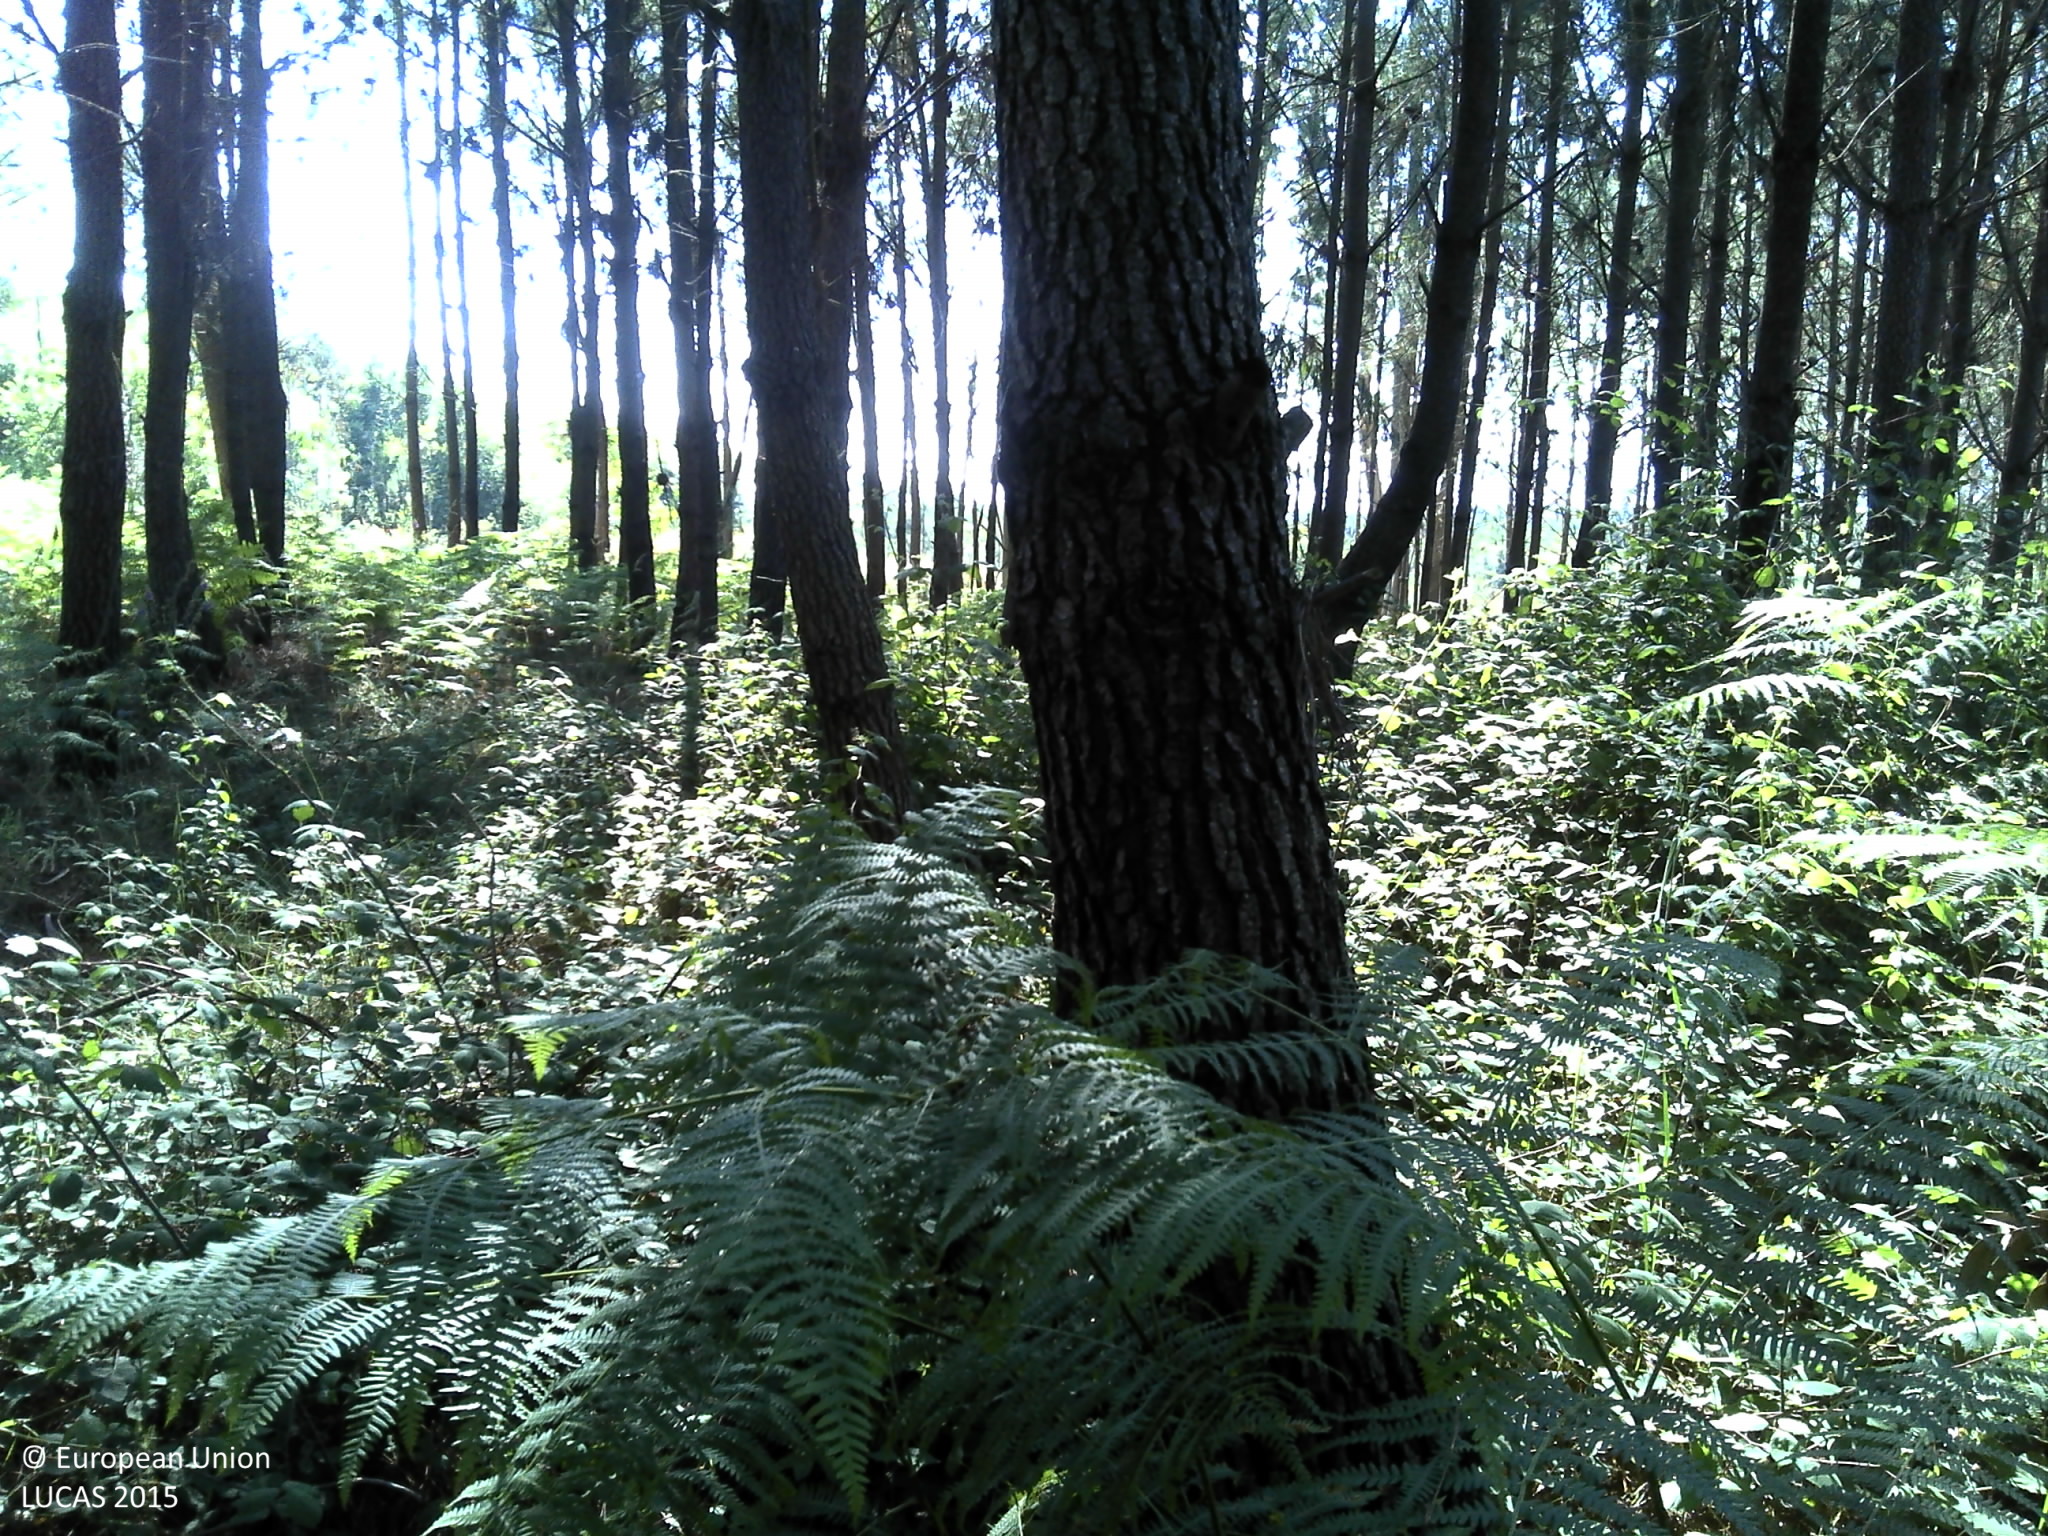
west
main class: Woodland
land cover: Pine dominated coniferous woodland
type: coniferous forest of the mediterranean region
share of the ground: 50 - 75 %
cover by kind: coniferous forest trees 75 %, broadleaved forest trees 20 %, shrubs 5 %
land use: Forestry
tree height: > 5 m
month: May
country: PT
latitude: 41.9724
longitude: -8.6677
